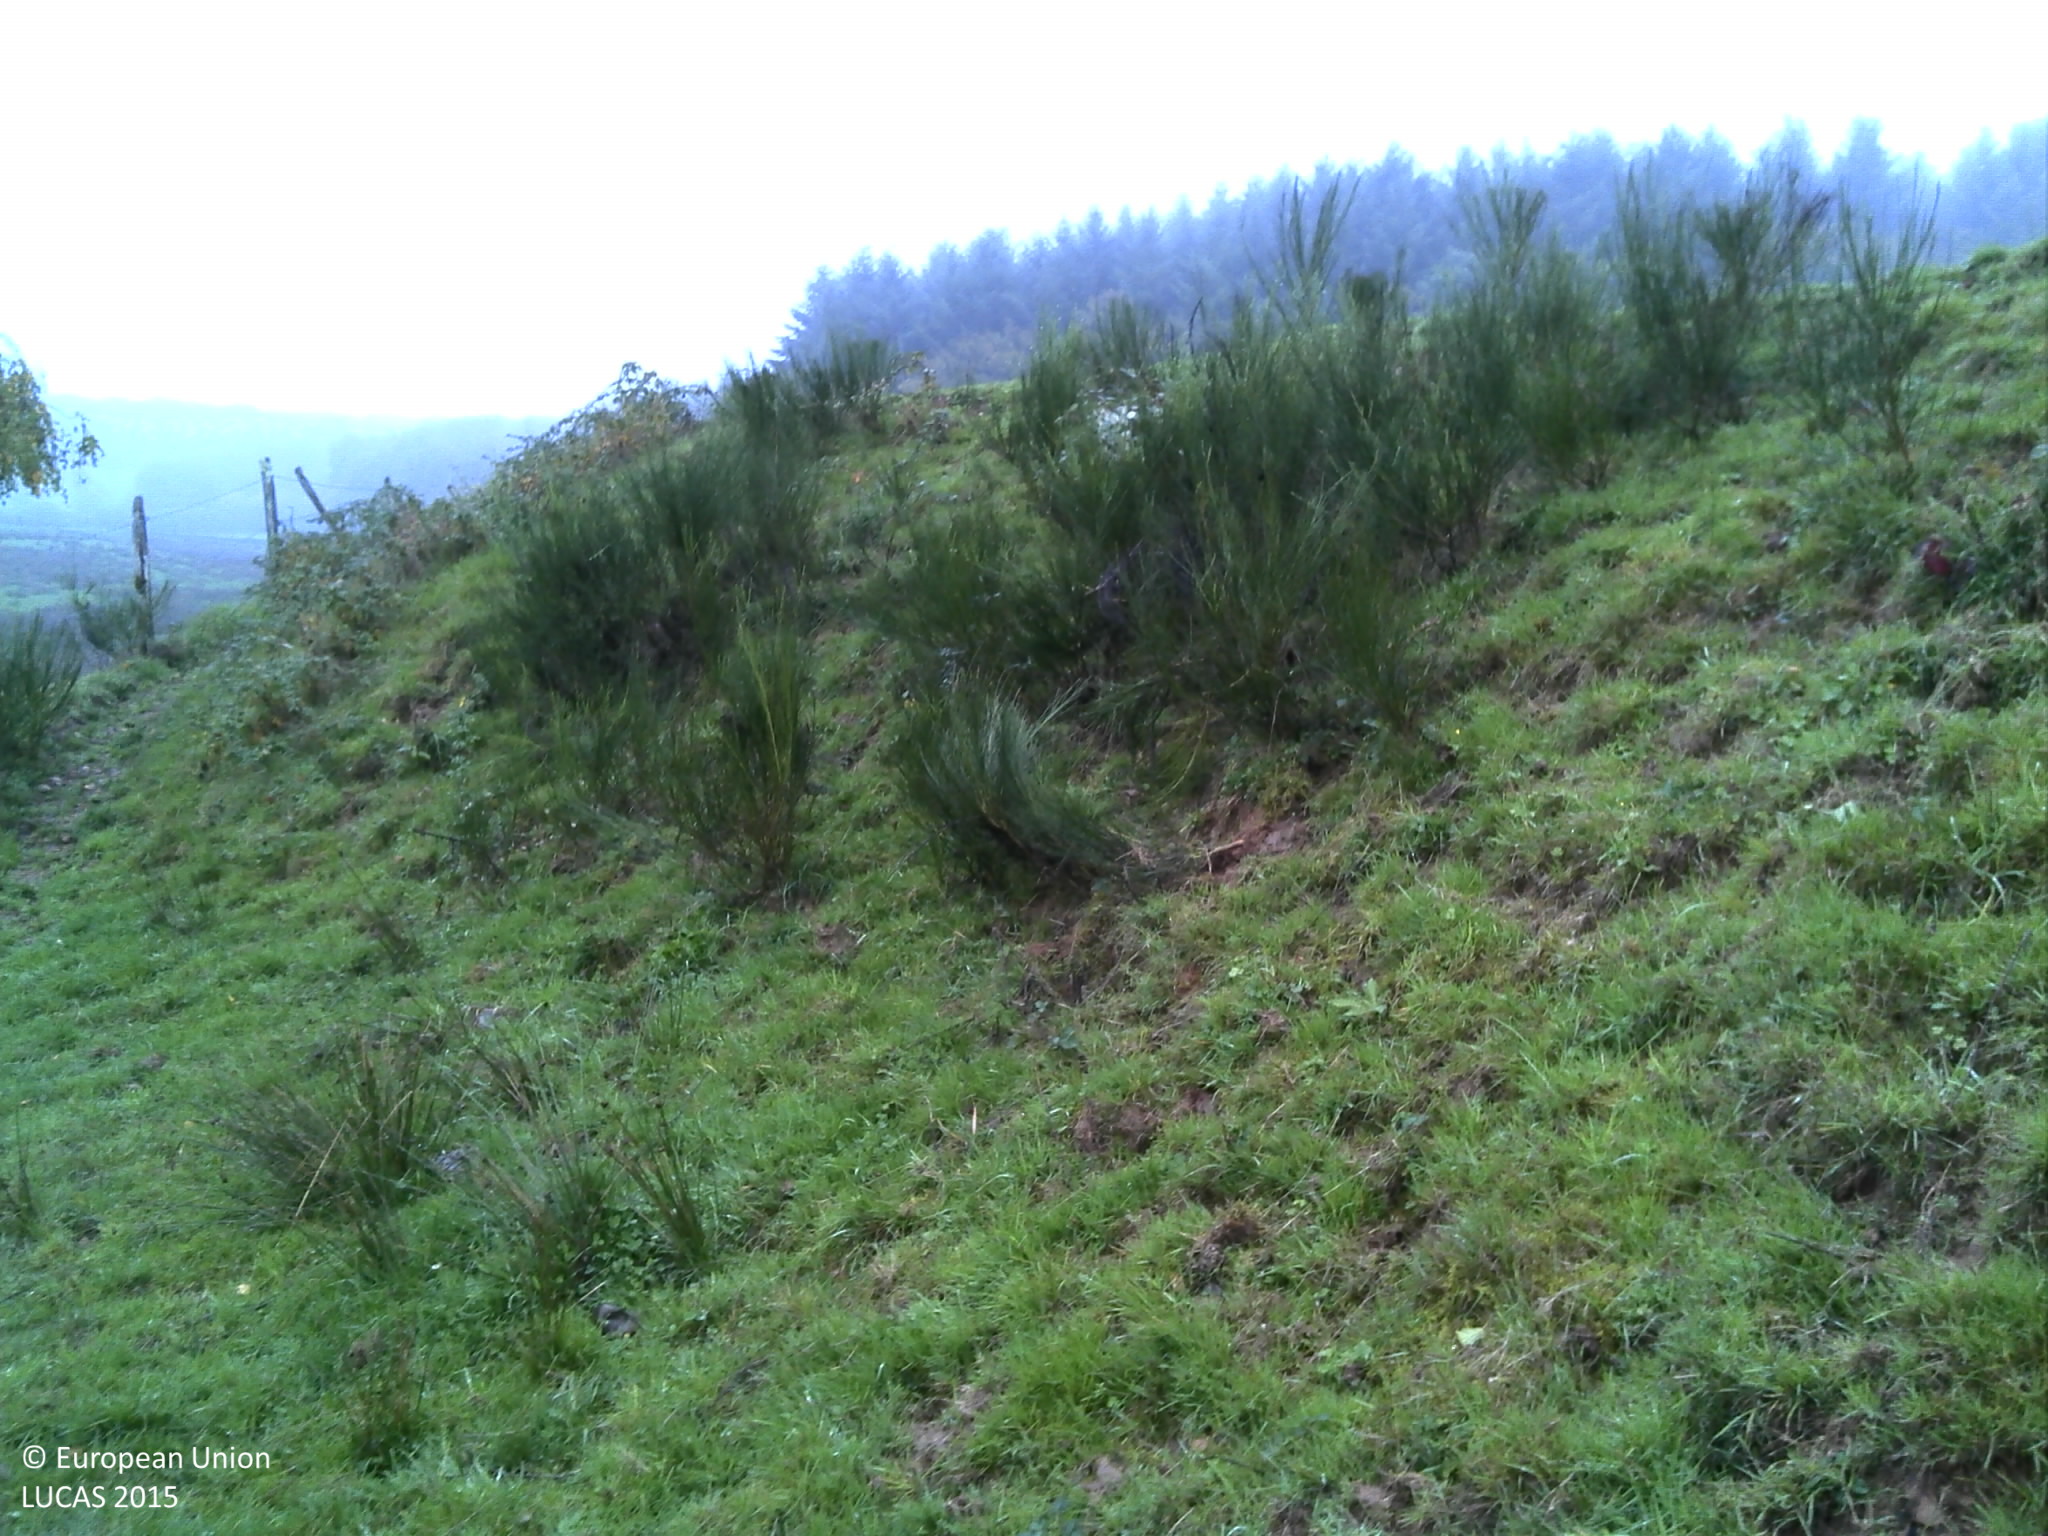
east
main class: Grassland
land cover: Grassland without tree/shrub cover
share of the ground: > 75 %
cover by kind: herbaceous plants 100 %
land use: Agriculture (excluding fallow land and kitchen gardens)
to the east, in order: Grassland without tree/shrub cover; Fences; Grassland without tree/shrub cover; Shrubland without tree cover; Rivers and streams; Shrubland without tree cover
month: October
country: FR
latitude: 46.5253
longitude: 3.9904
